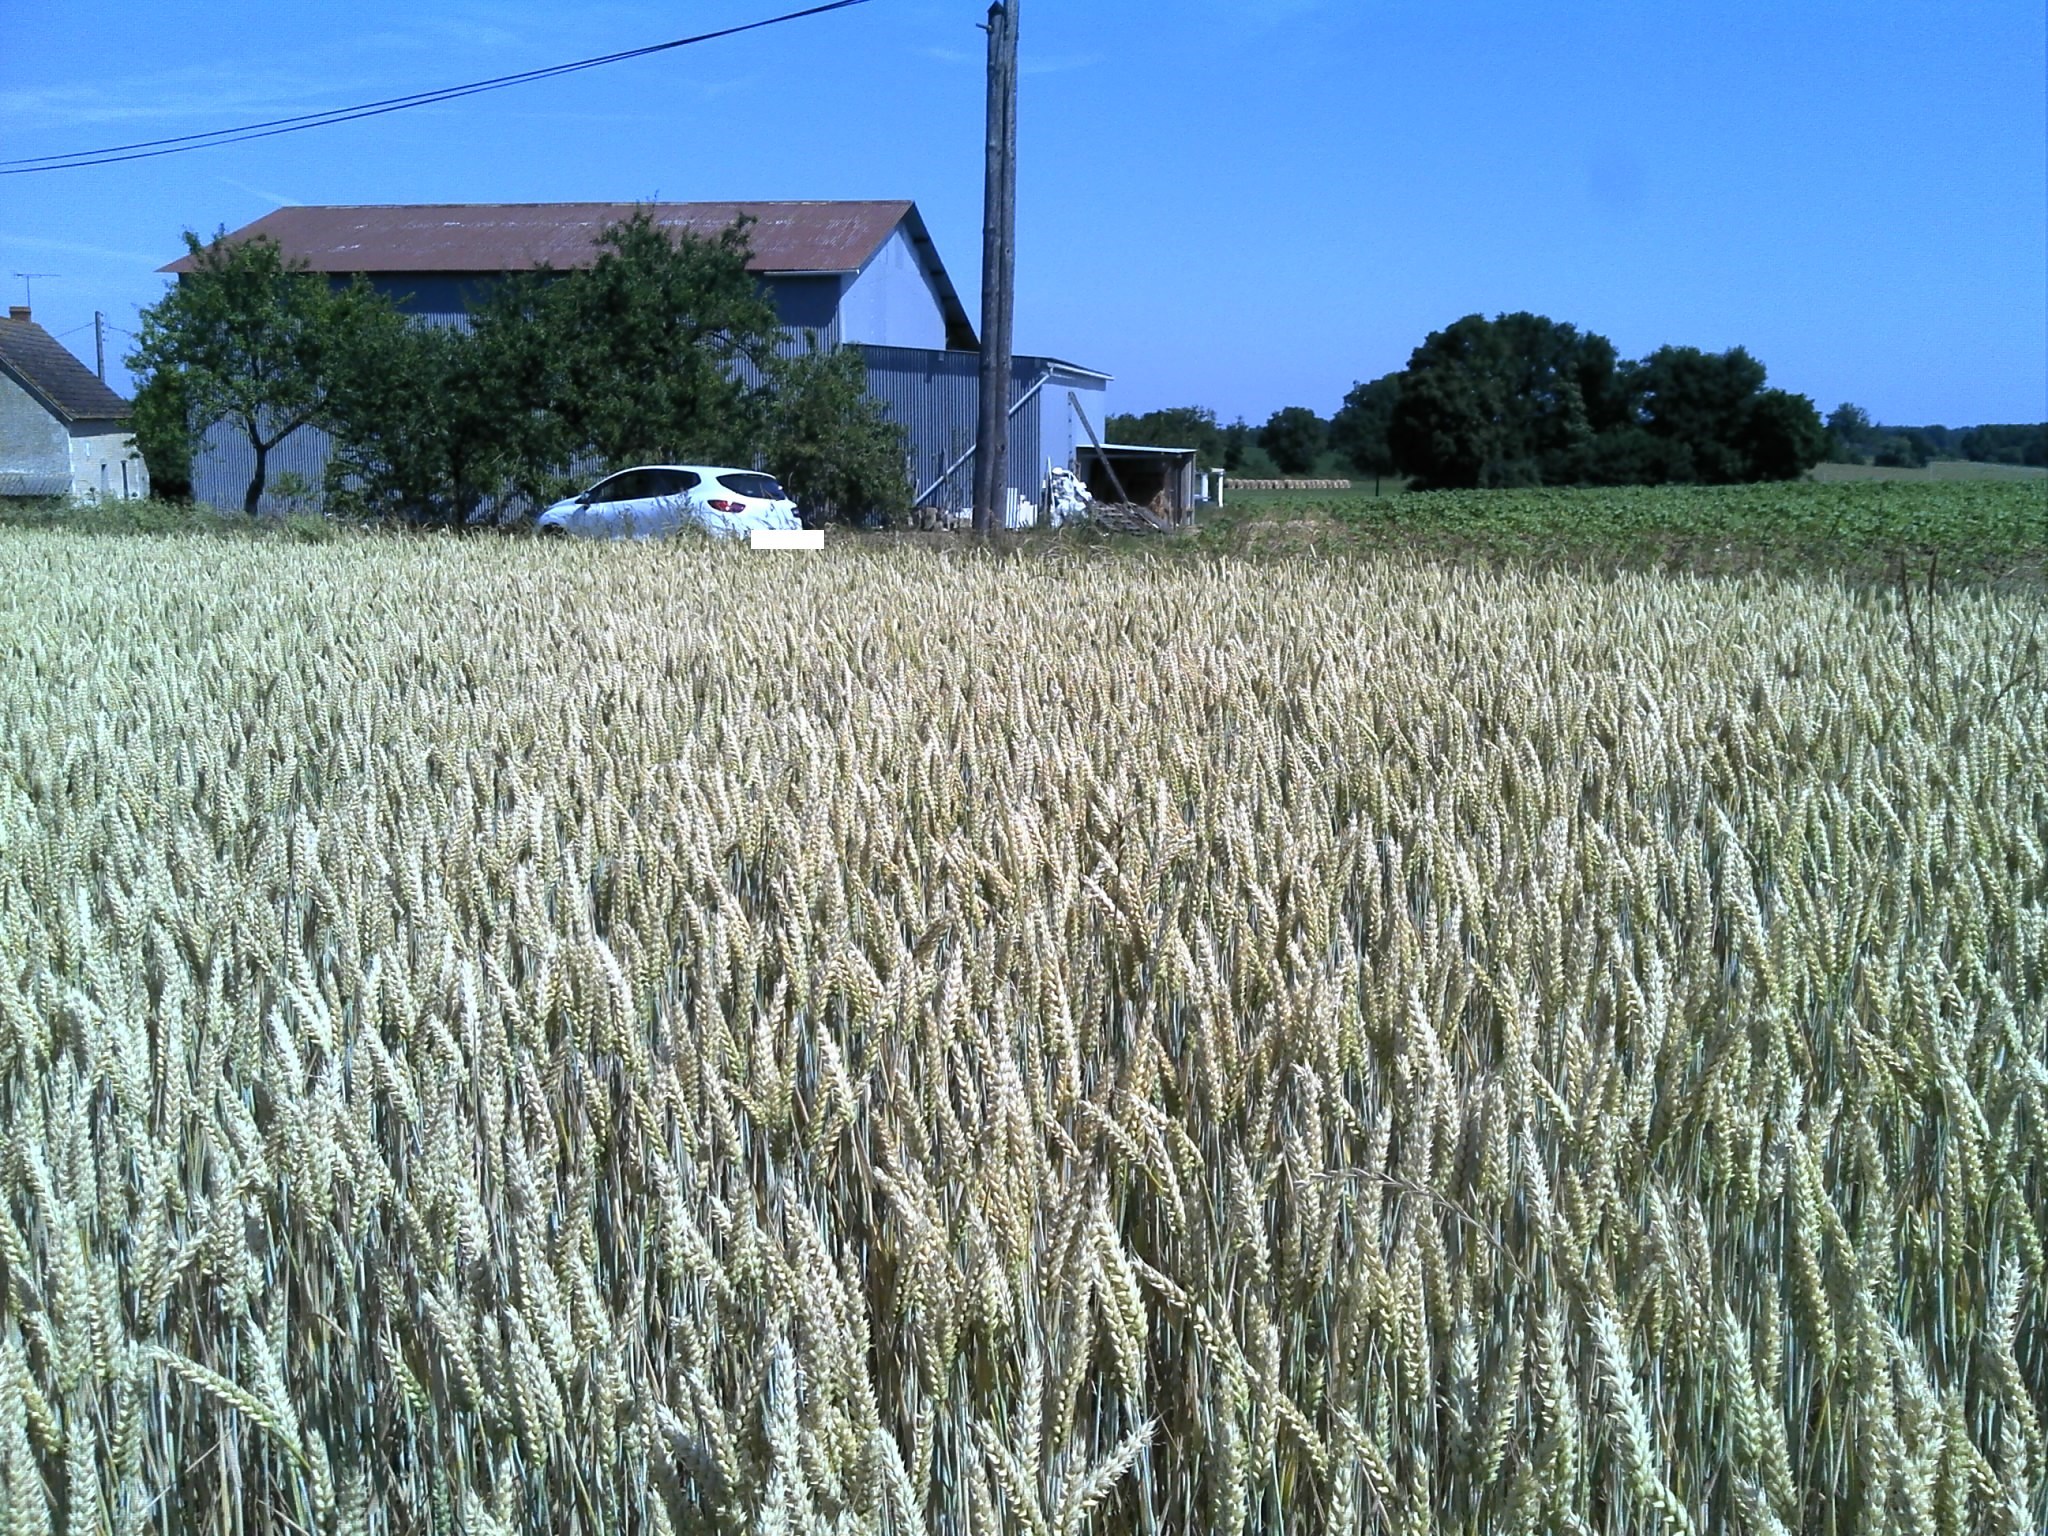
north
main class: Cropland
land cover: Common wheat
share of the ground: > 75 %
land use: Agriculture (excluding fallow land and kitchen gardens)
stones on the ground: < 10 %
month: June
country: FR
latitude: 47.1809
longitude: 1.3962
